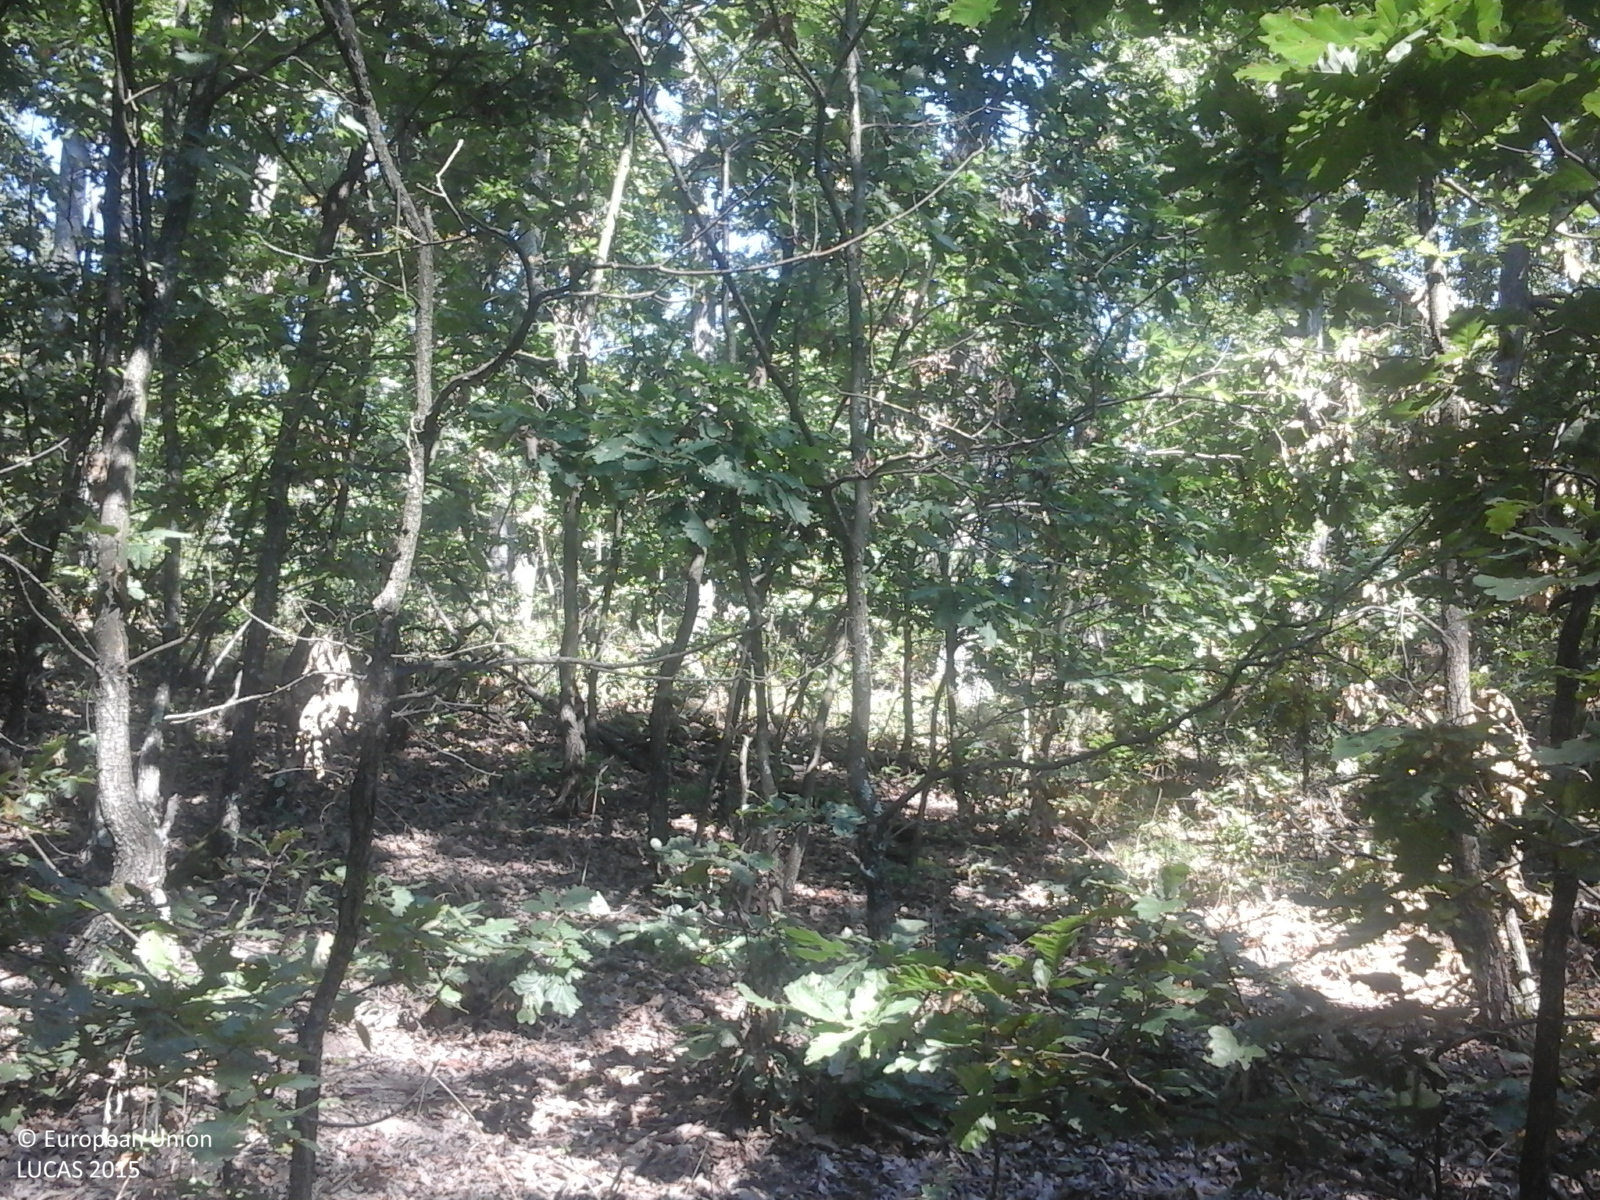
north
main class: Woodland
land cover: Broadleaved woodland
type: acidophilous oak and oak-birch forest
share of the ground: > 75 %
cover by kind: broadleaved forest trees 100 %
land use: Forestry
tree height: > 5 m
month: September
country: RO
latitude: 47.3930
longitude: 22.7120
